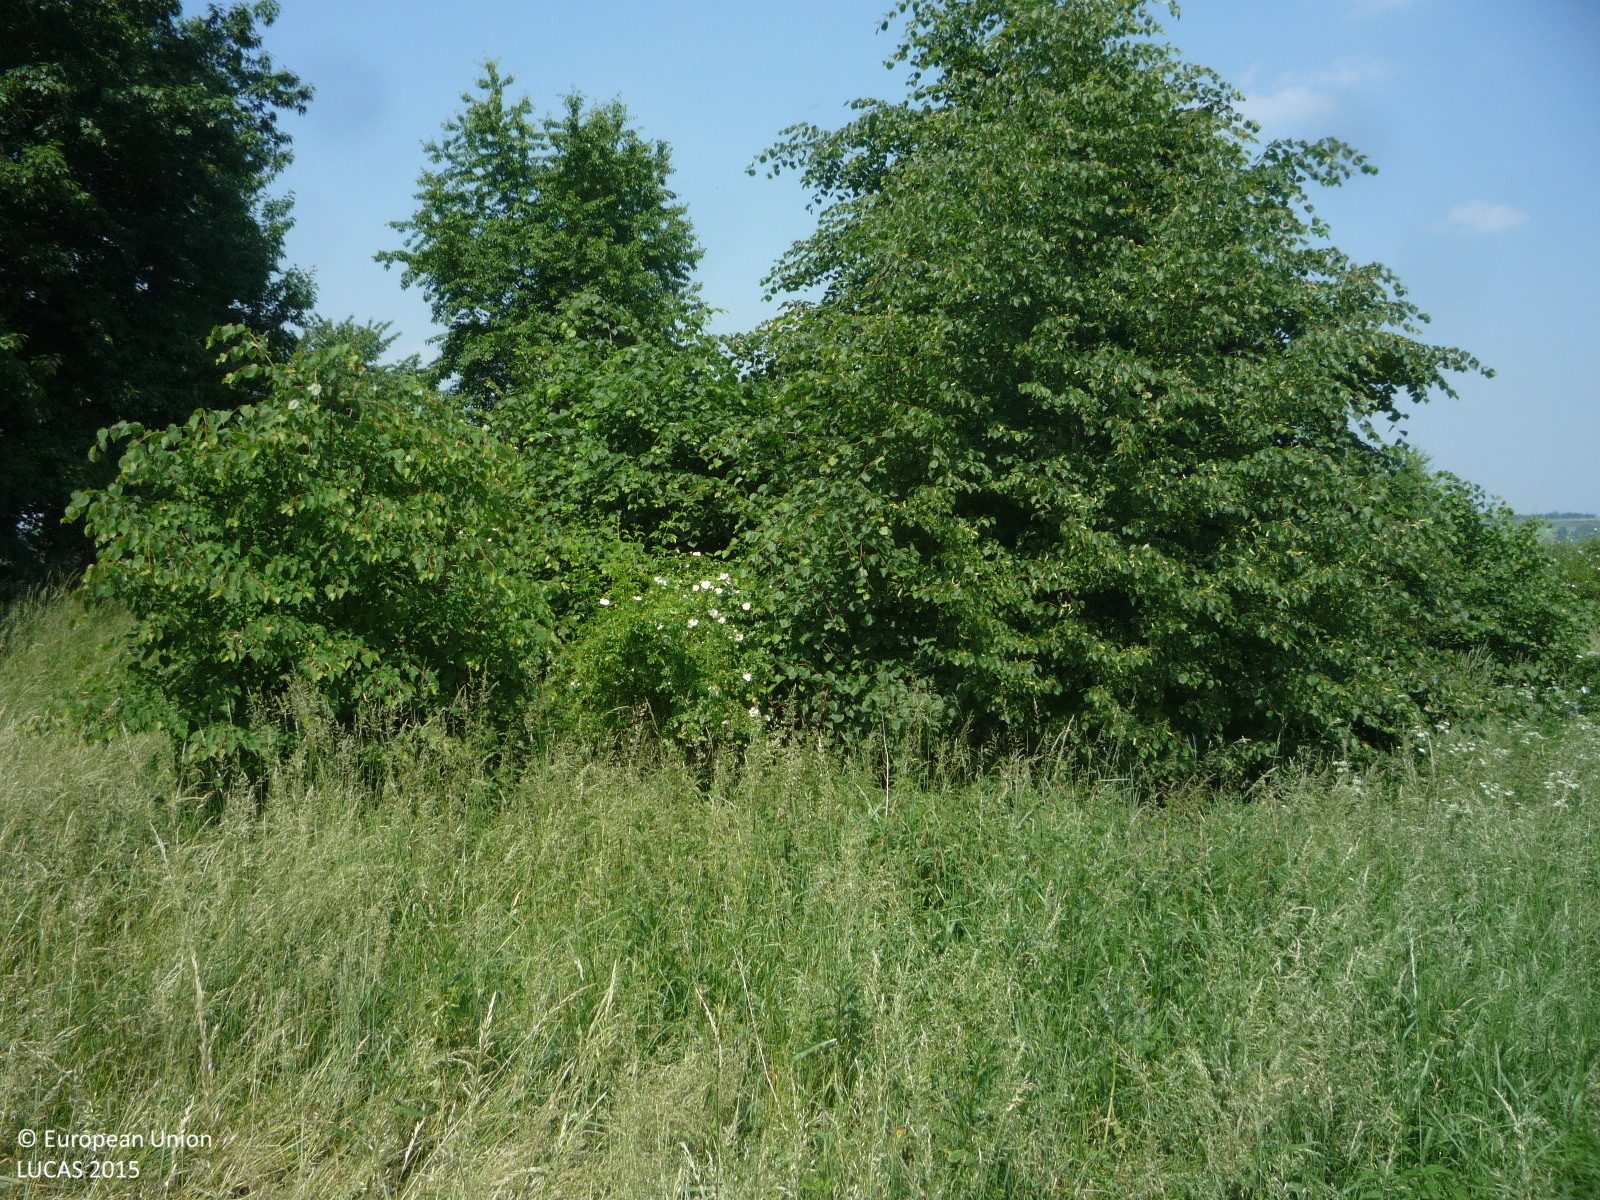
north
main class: Grassland
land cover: Grassland with sparse tree/shrub cover
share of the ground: > 75 %
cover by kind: herbaceous plants 90 %, broadleaved forest trees 5 %, shrubs 5 %
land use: Semi-natural and natural areas not in use
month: June
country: CZ
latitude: 50.2562
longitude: 14.0545
